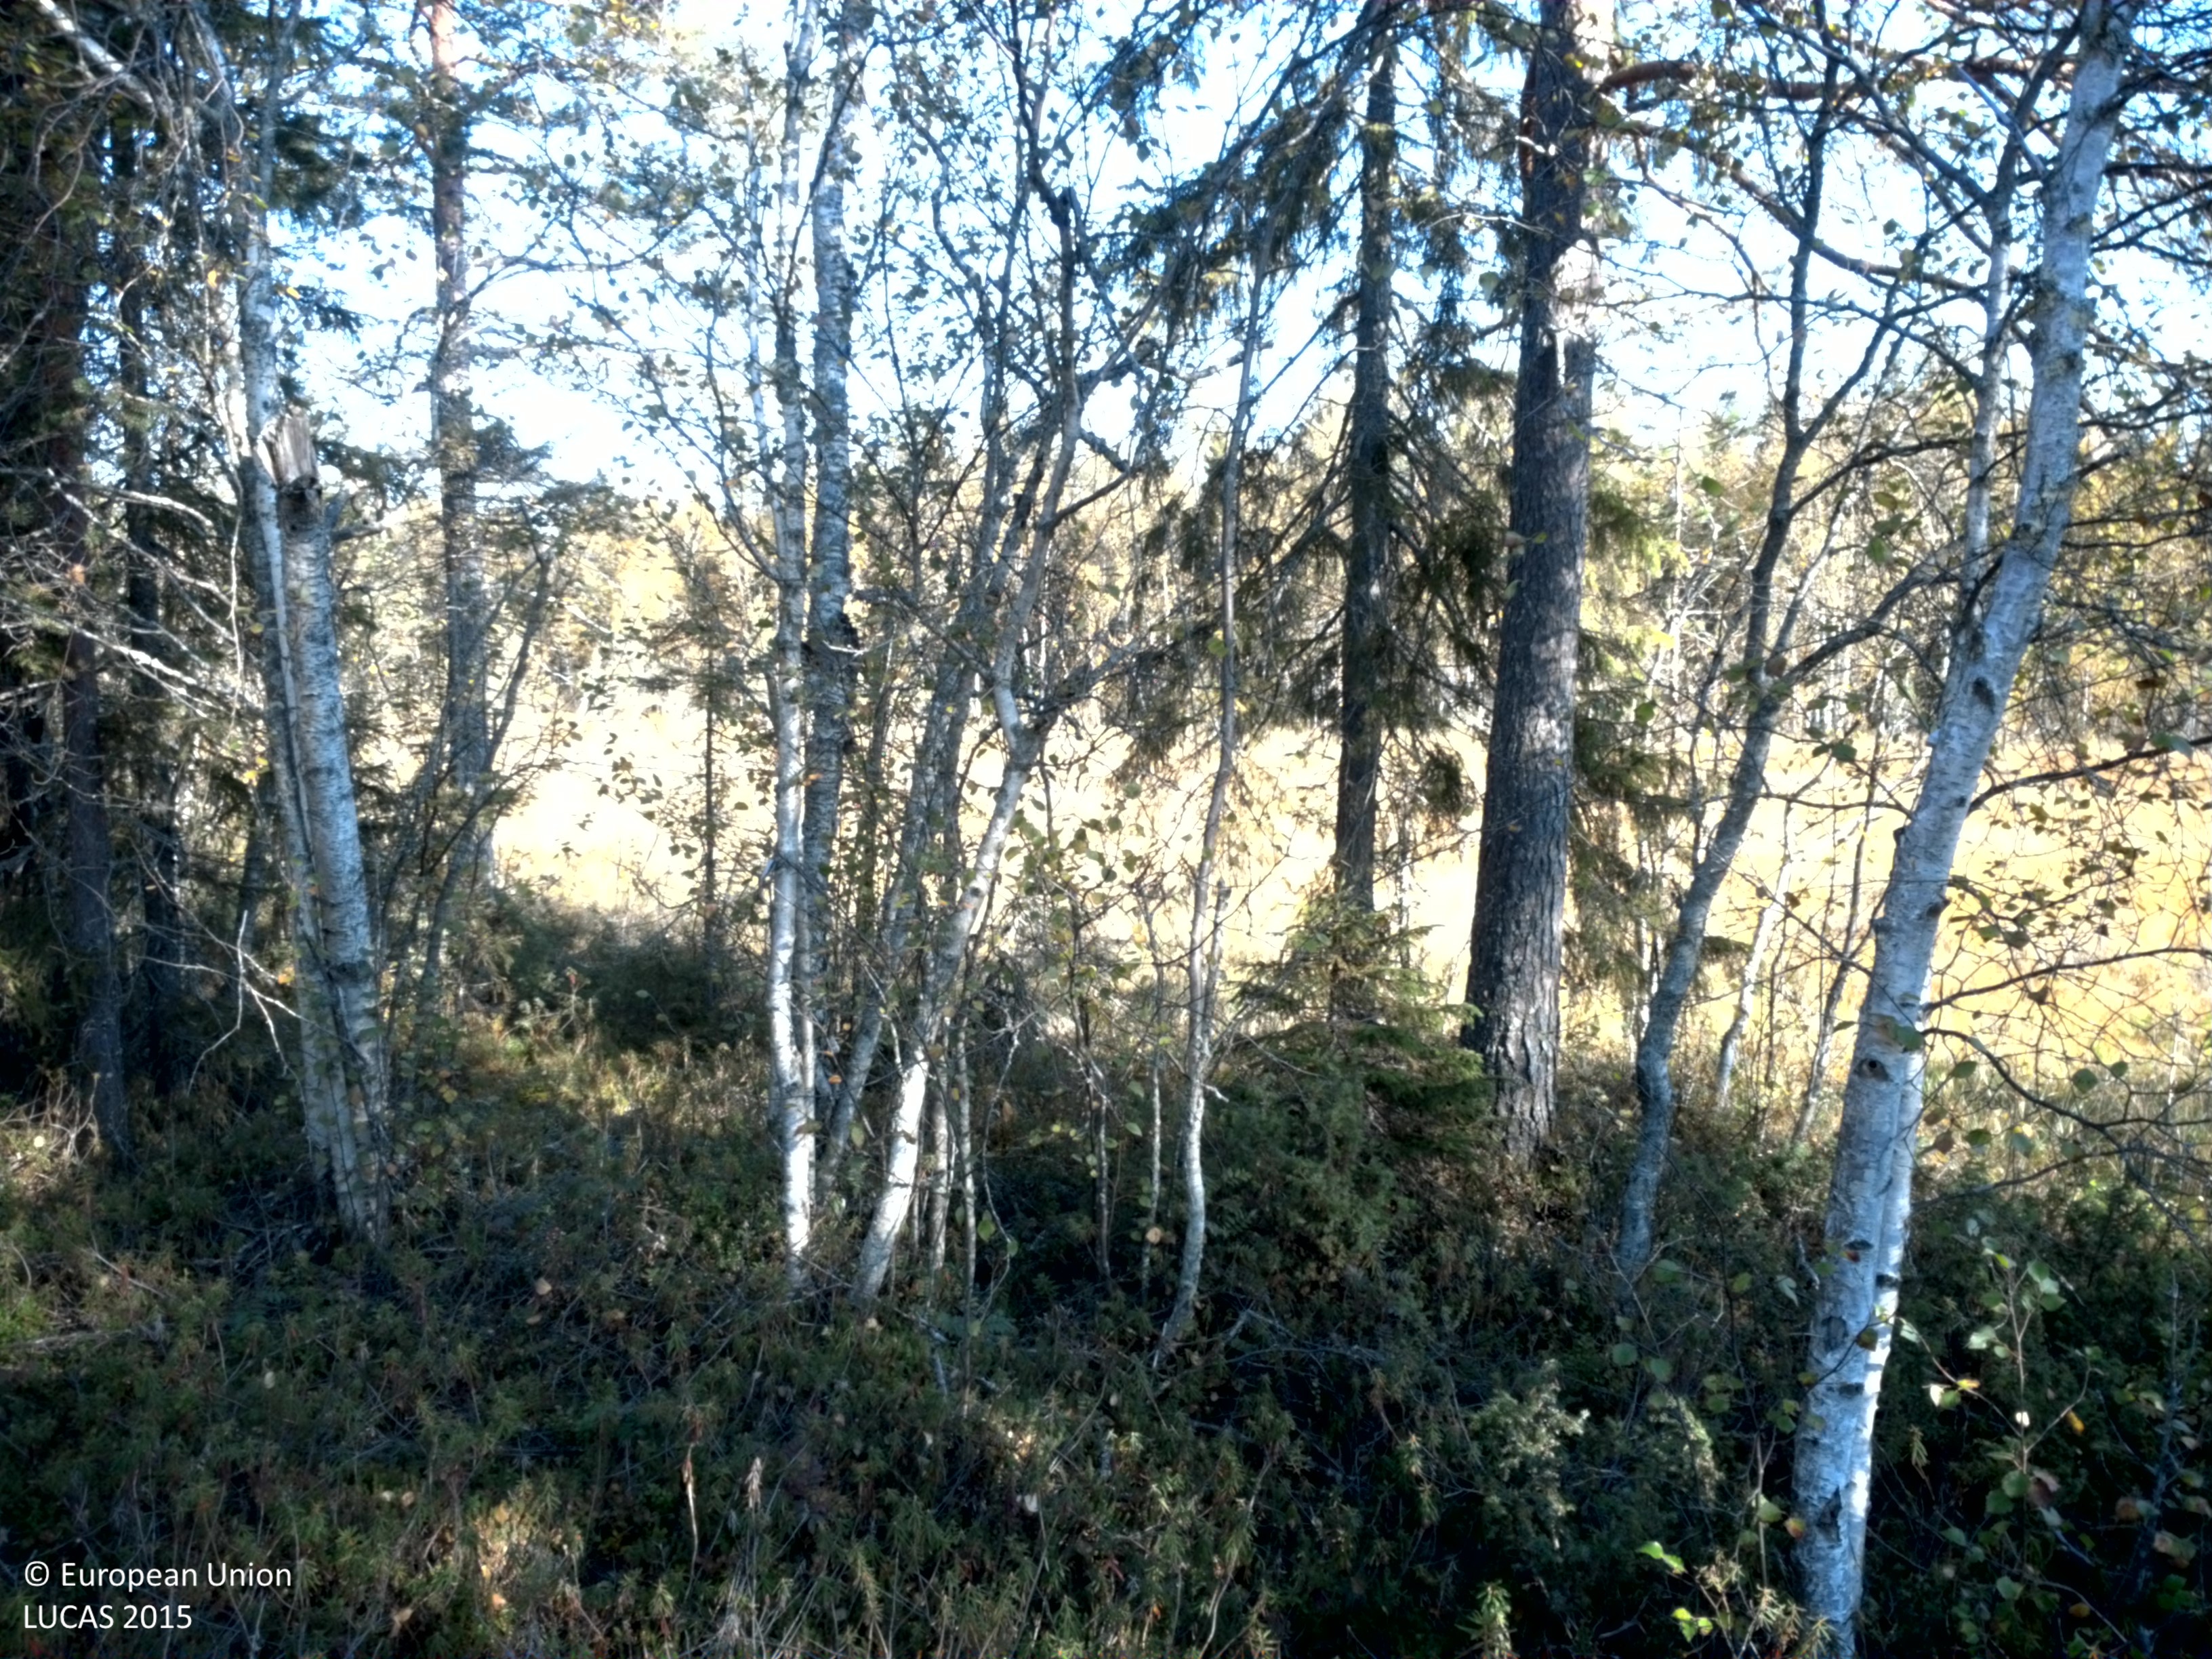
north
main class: Woodland
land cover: Pine dominated mixed woodland
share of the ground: 25 - 50 %
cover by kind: shrubs 60 %, coniferous forest trees 20 %, broadleaved forest trees 20 %
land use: Forestry
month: September
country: SE
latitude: 65.8976
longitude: 22.5548
